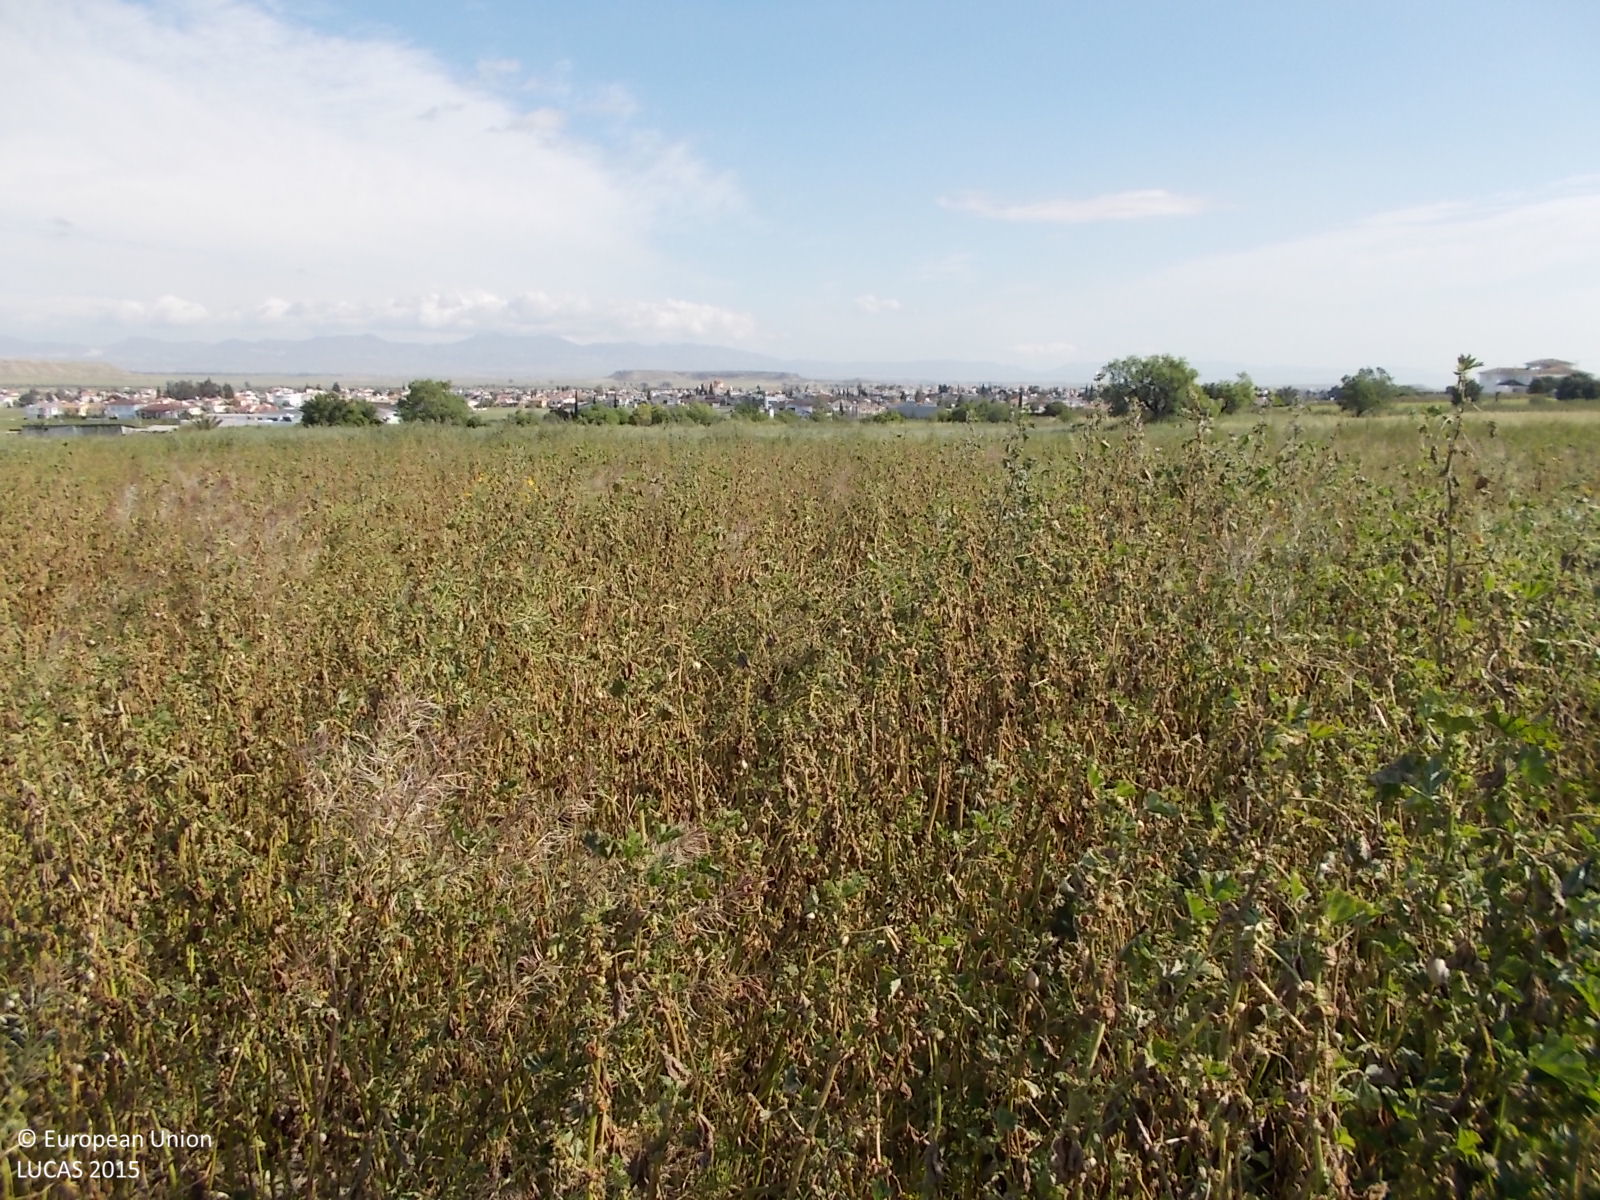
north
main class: Grassland
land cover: Spontaneously vegetated surfaces
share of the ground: > 75 %
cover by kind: herbaceous plants 100 %
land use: Fallow land
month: April
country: CY
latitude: 35.0489
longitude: 33.5380
